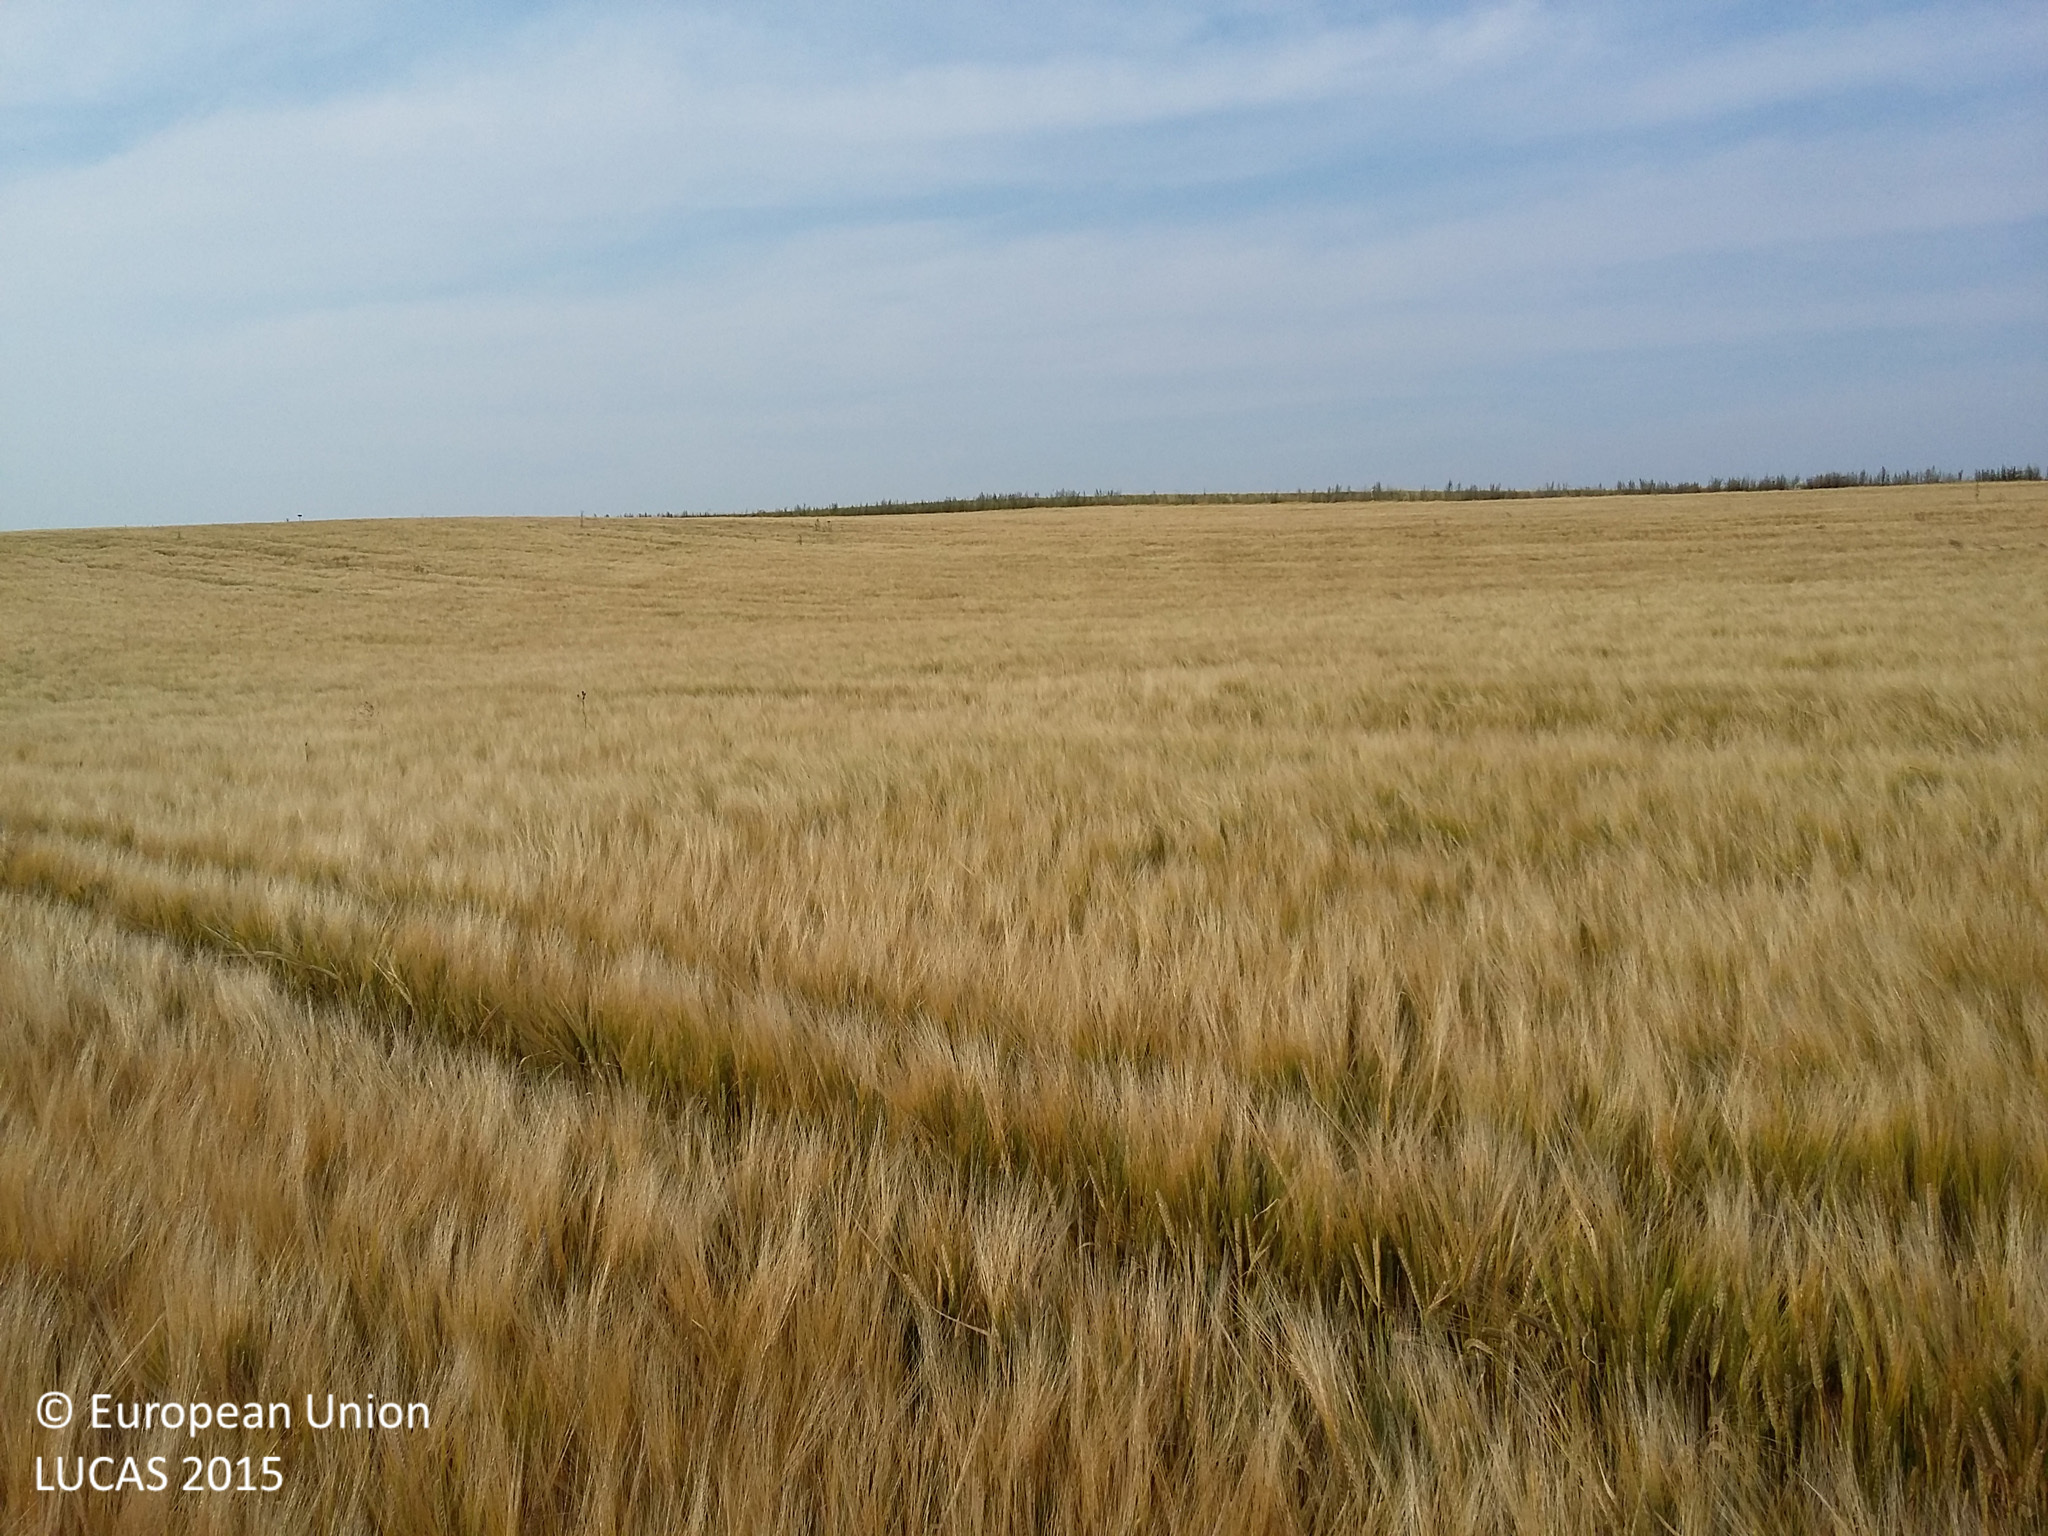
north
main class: Cropland
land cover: Barley
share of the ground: > 75 %
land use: Agriculture (excluding fallow land and kitchen gardens)
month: August
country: DK
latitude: 55.5092
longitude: 11.8511
